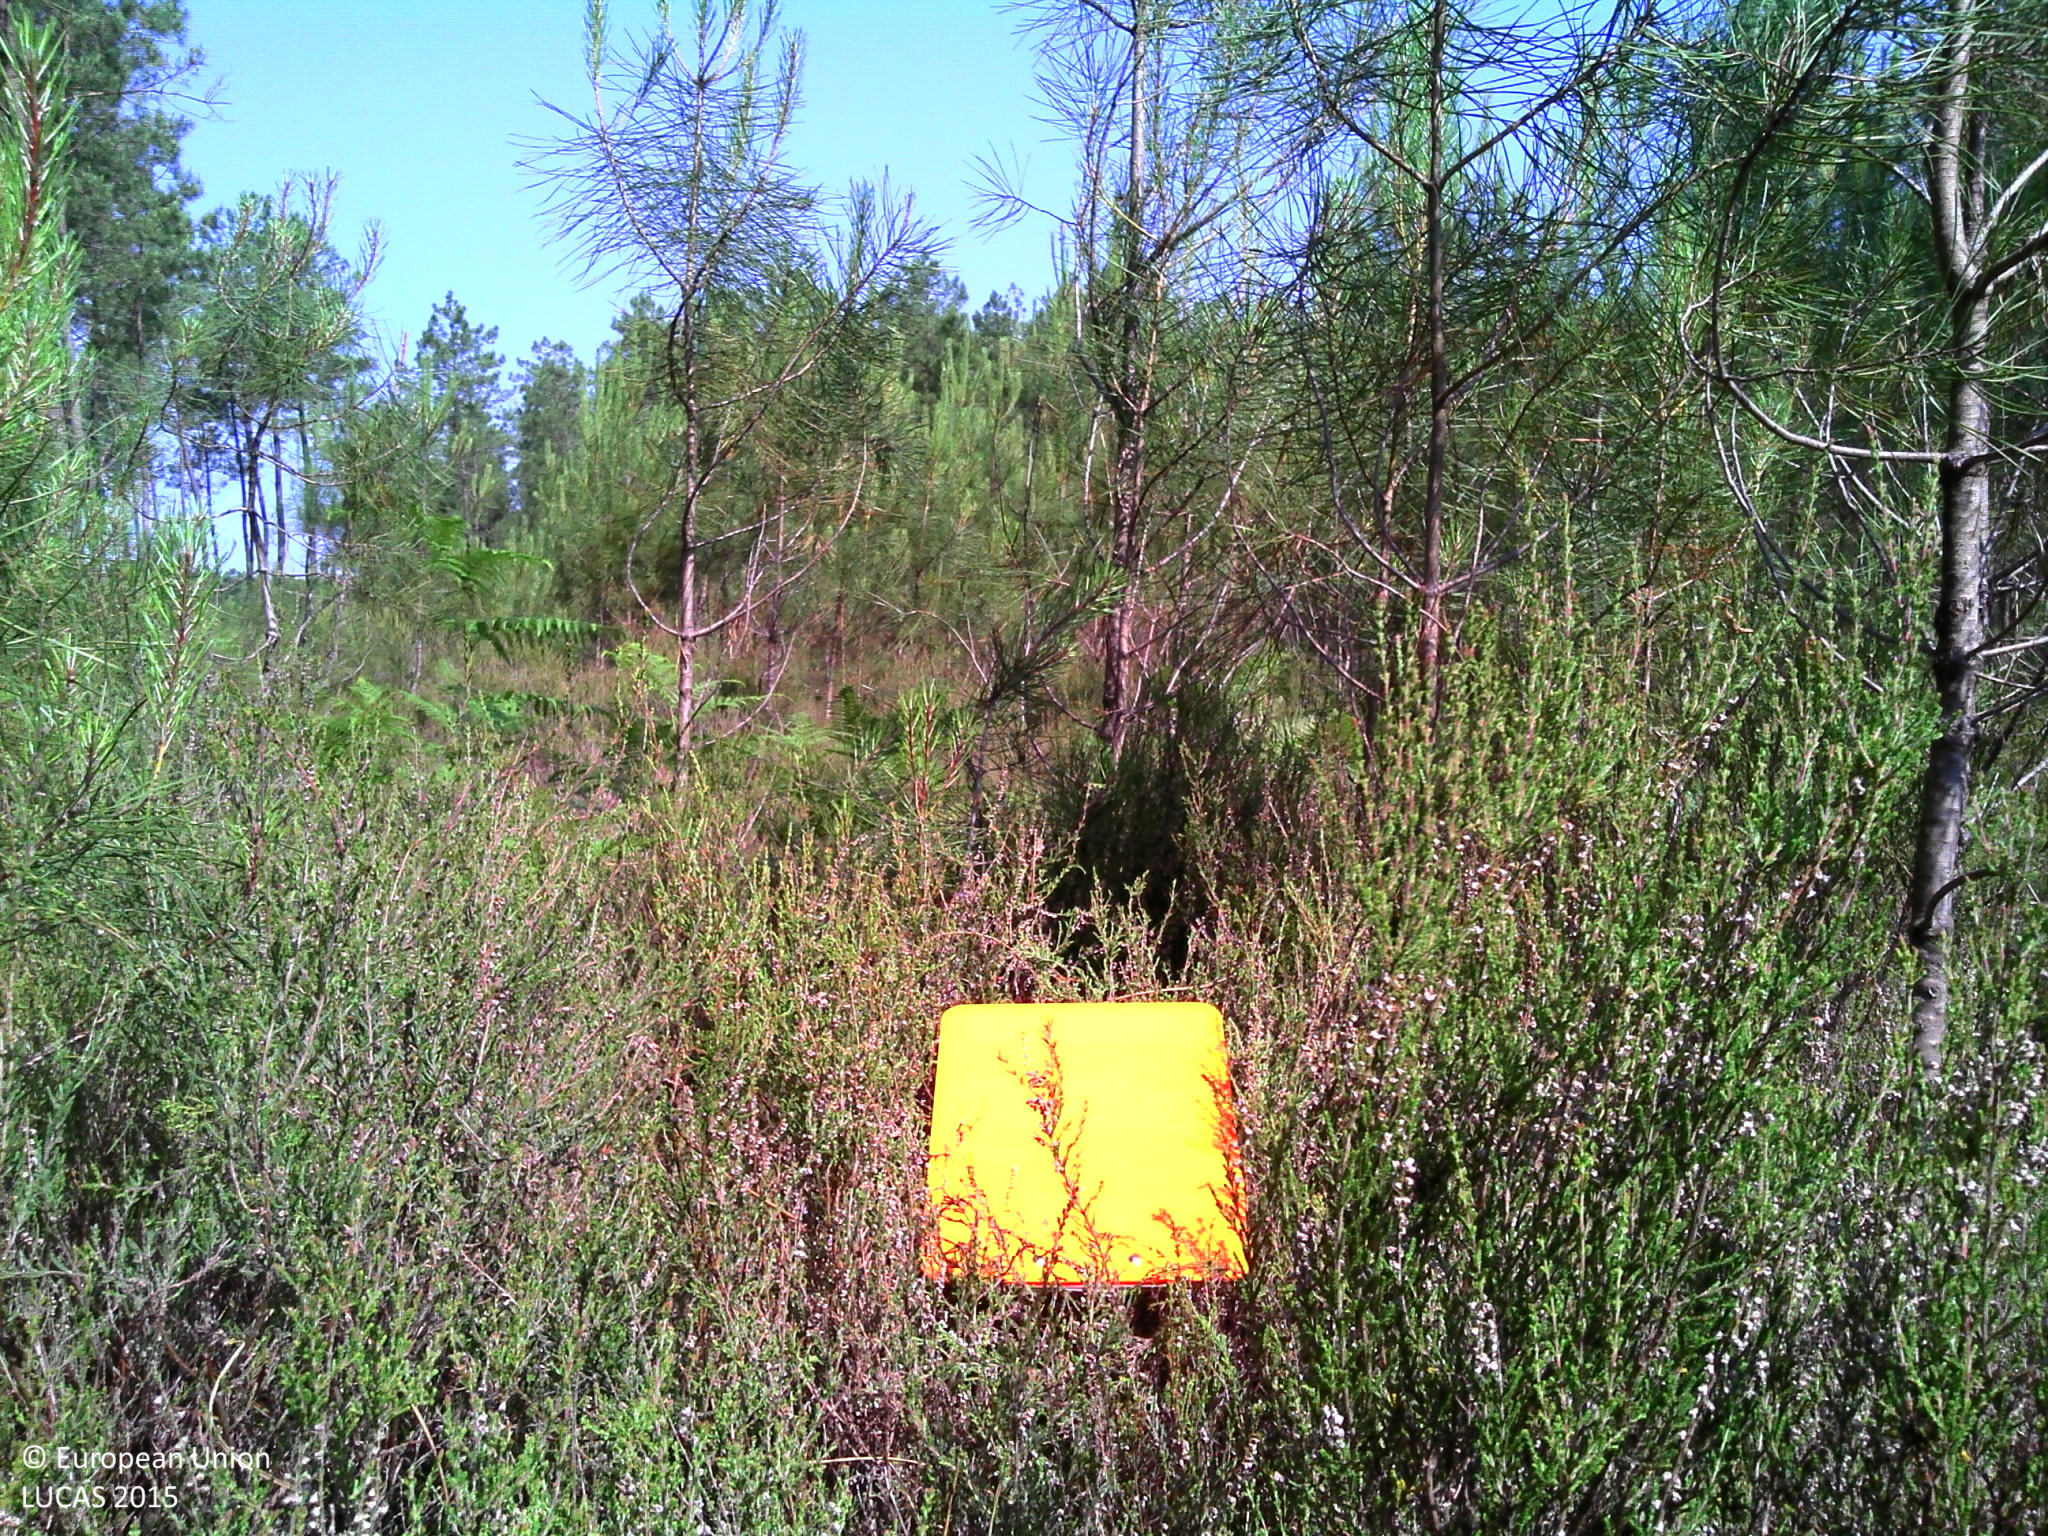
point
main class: Woodland
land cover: Pine dominated coniferous woodland
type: coniferous forest of the mediterranean region
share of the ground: > 75 %
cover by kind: coniferous forest trees 80 %, shrubs 15 %, herbaceous plants 5 %
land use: Forestry
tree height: > 5 m
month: June
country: FR
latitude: 44.0920
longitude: -0.2908
